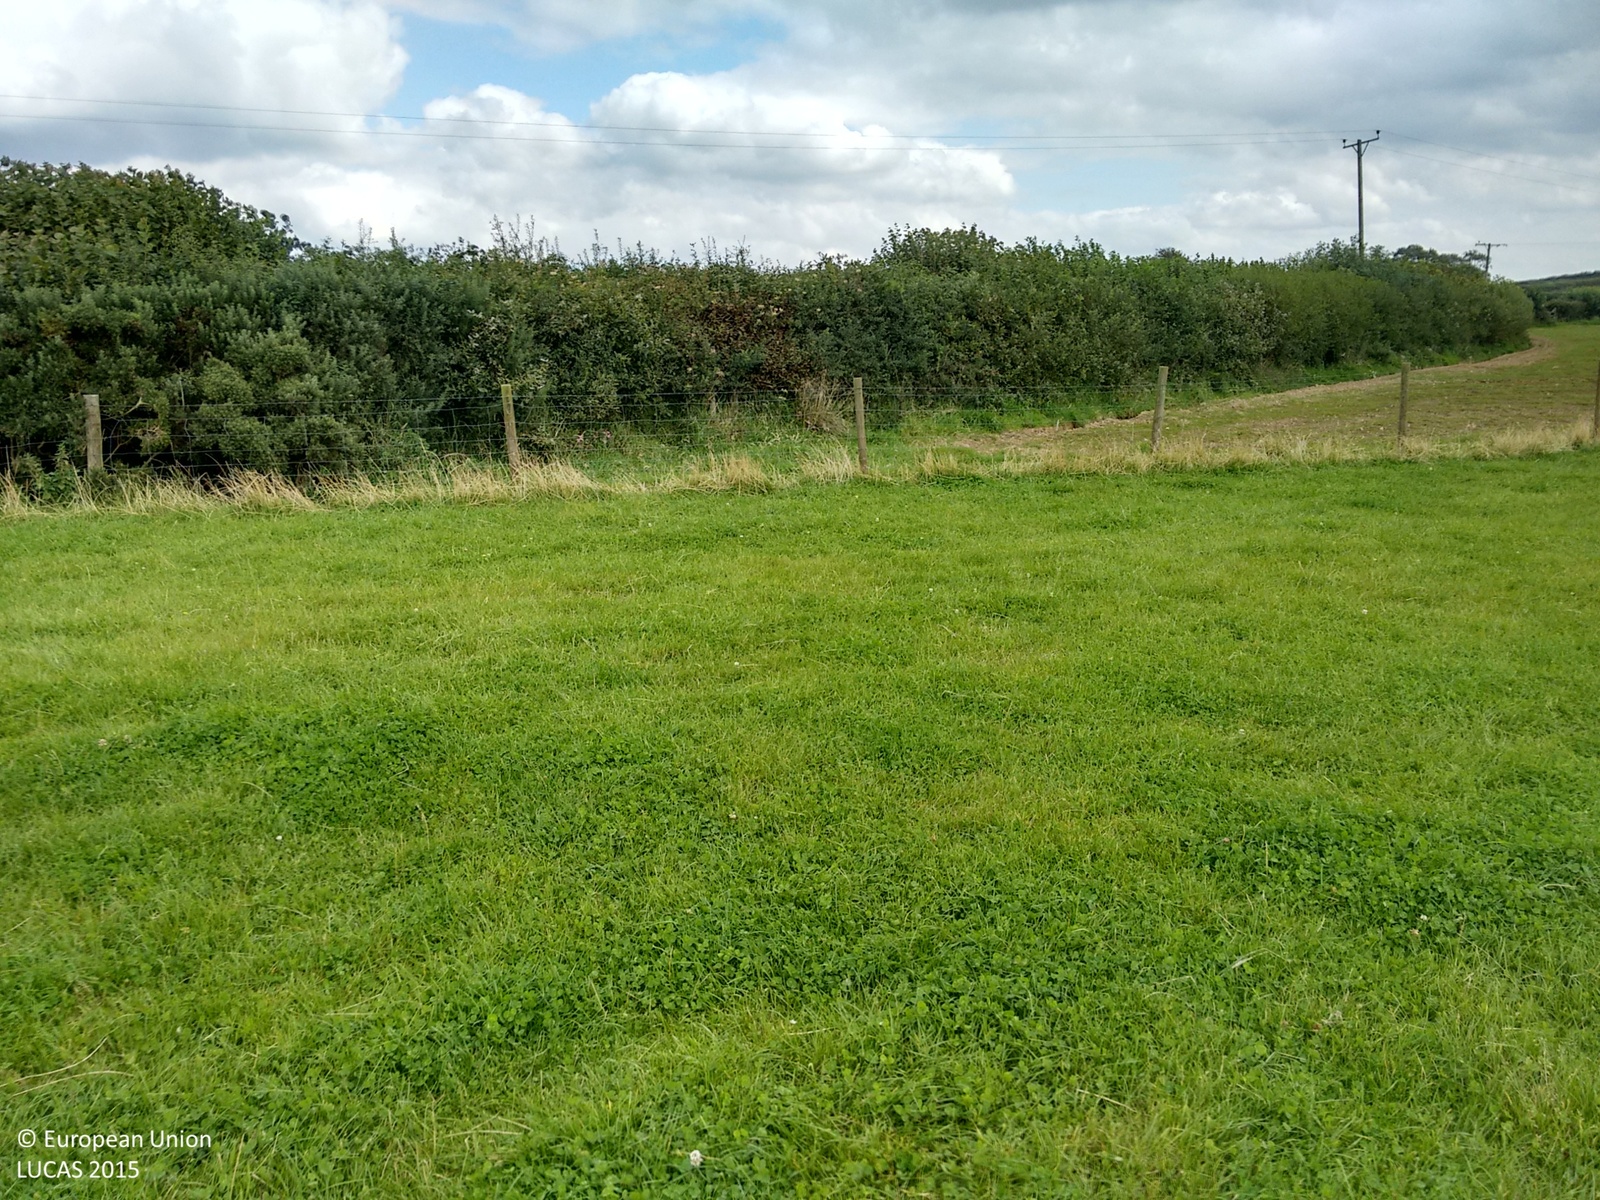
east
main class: Grassland
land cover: Grassland without tree/shrub cover
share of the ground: > 75 %
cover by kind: herbaceous plants 100 %
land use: Agriculture (excluding fallow land and kitchen gardens)
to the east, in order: Grassland without tree/shrub cover; Fences; Spontaneously vegetated surfaces; Fences; Managed hedges; Artificial constructions; Spontaneously vegetated surfaces; Electric lines; Spontaneously vegetated surfaces; Managed hedges; Artificial constructions; Grass margins; Paved roads, cycling and walking lanes; Grass margins; Managed hedges; Artificial constructions; Fences; Grassland without tree/shrub cover
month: September
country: GB
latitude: 50.9195
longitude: -4.3116
